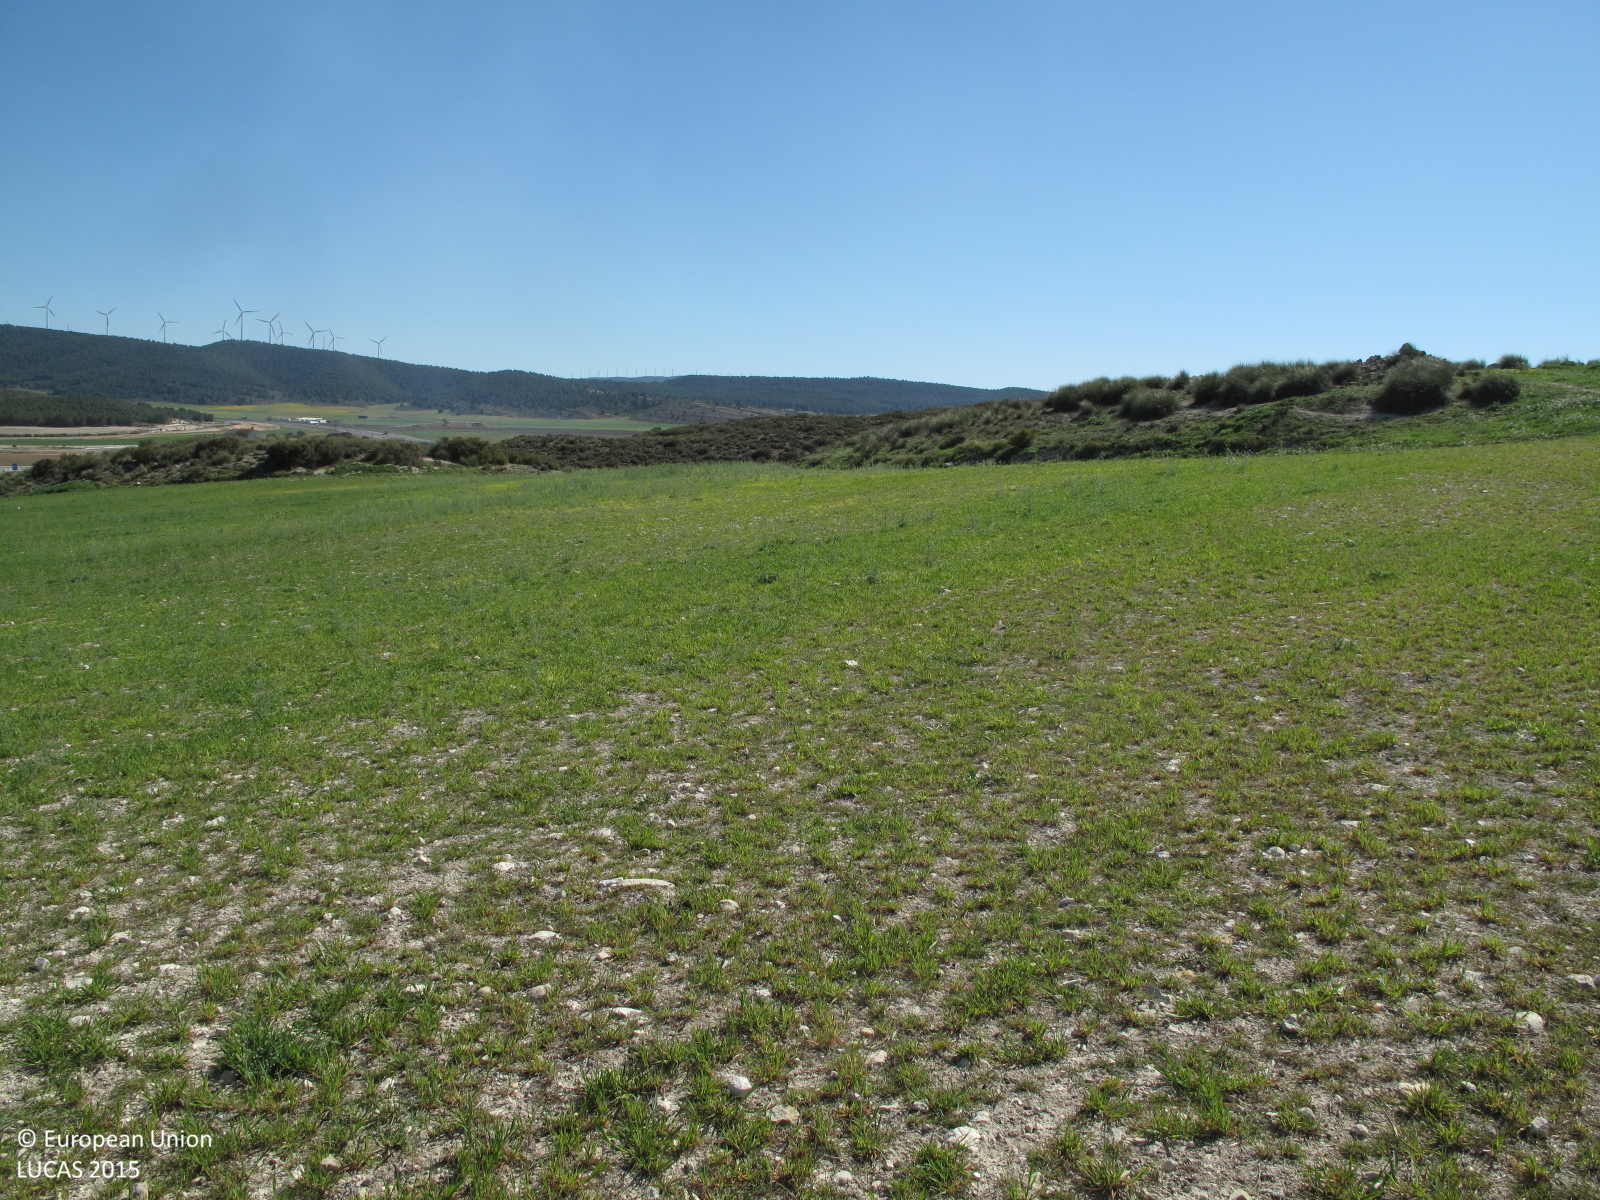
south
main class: Grassland
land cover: Spontaneously vegetated surfaces
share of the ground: 50 - 75 %
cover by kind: herbaceous plants 70 %, unconsolidated bare surface 30 %
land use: Fallow land
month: March
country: ES
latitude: 38.8415
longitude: -1.0190
